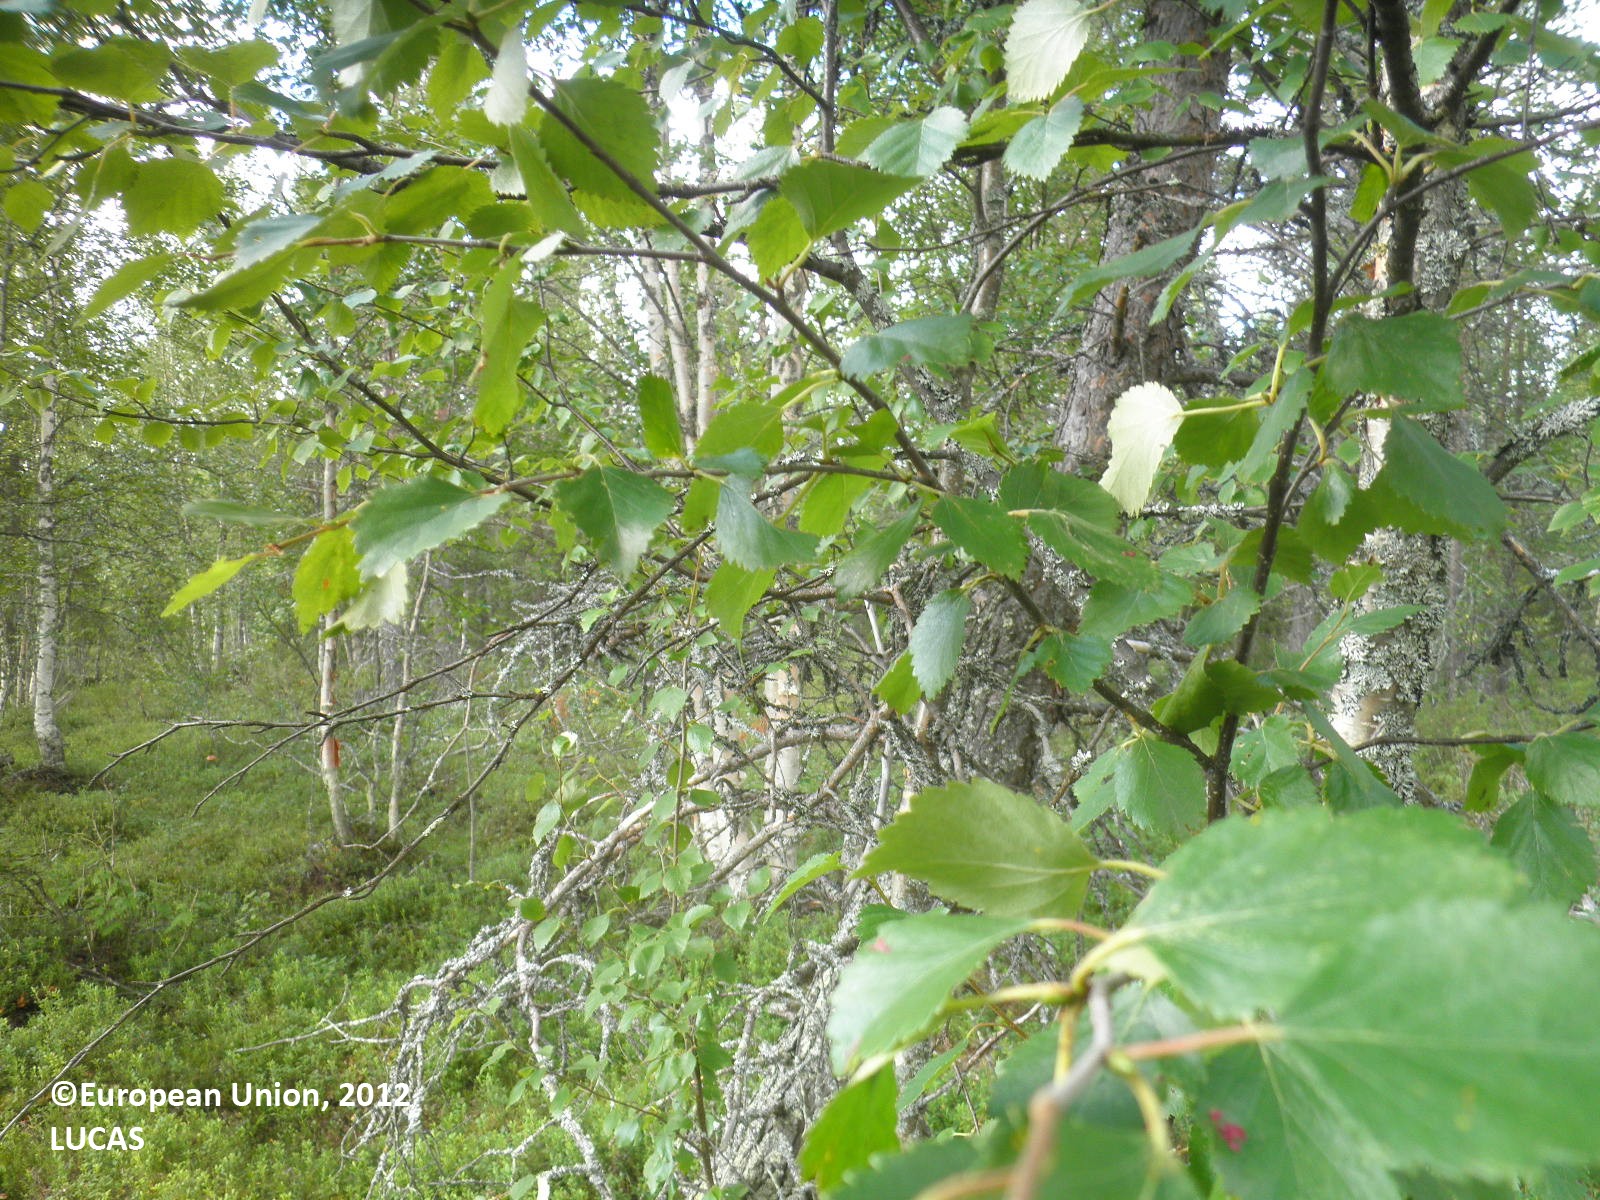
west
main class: Woodland
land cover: Pine dominated mixed woodland
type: boreal forest
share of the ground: 25 - 50 %
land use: Forestry
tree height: > 5 m
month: August
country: FI
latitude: 67.3968
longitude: 27.7566
